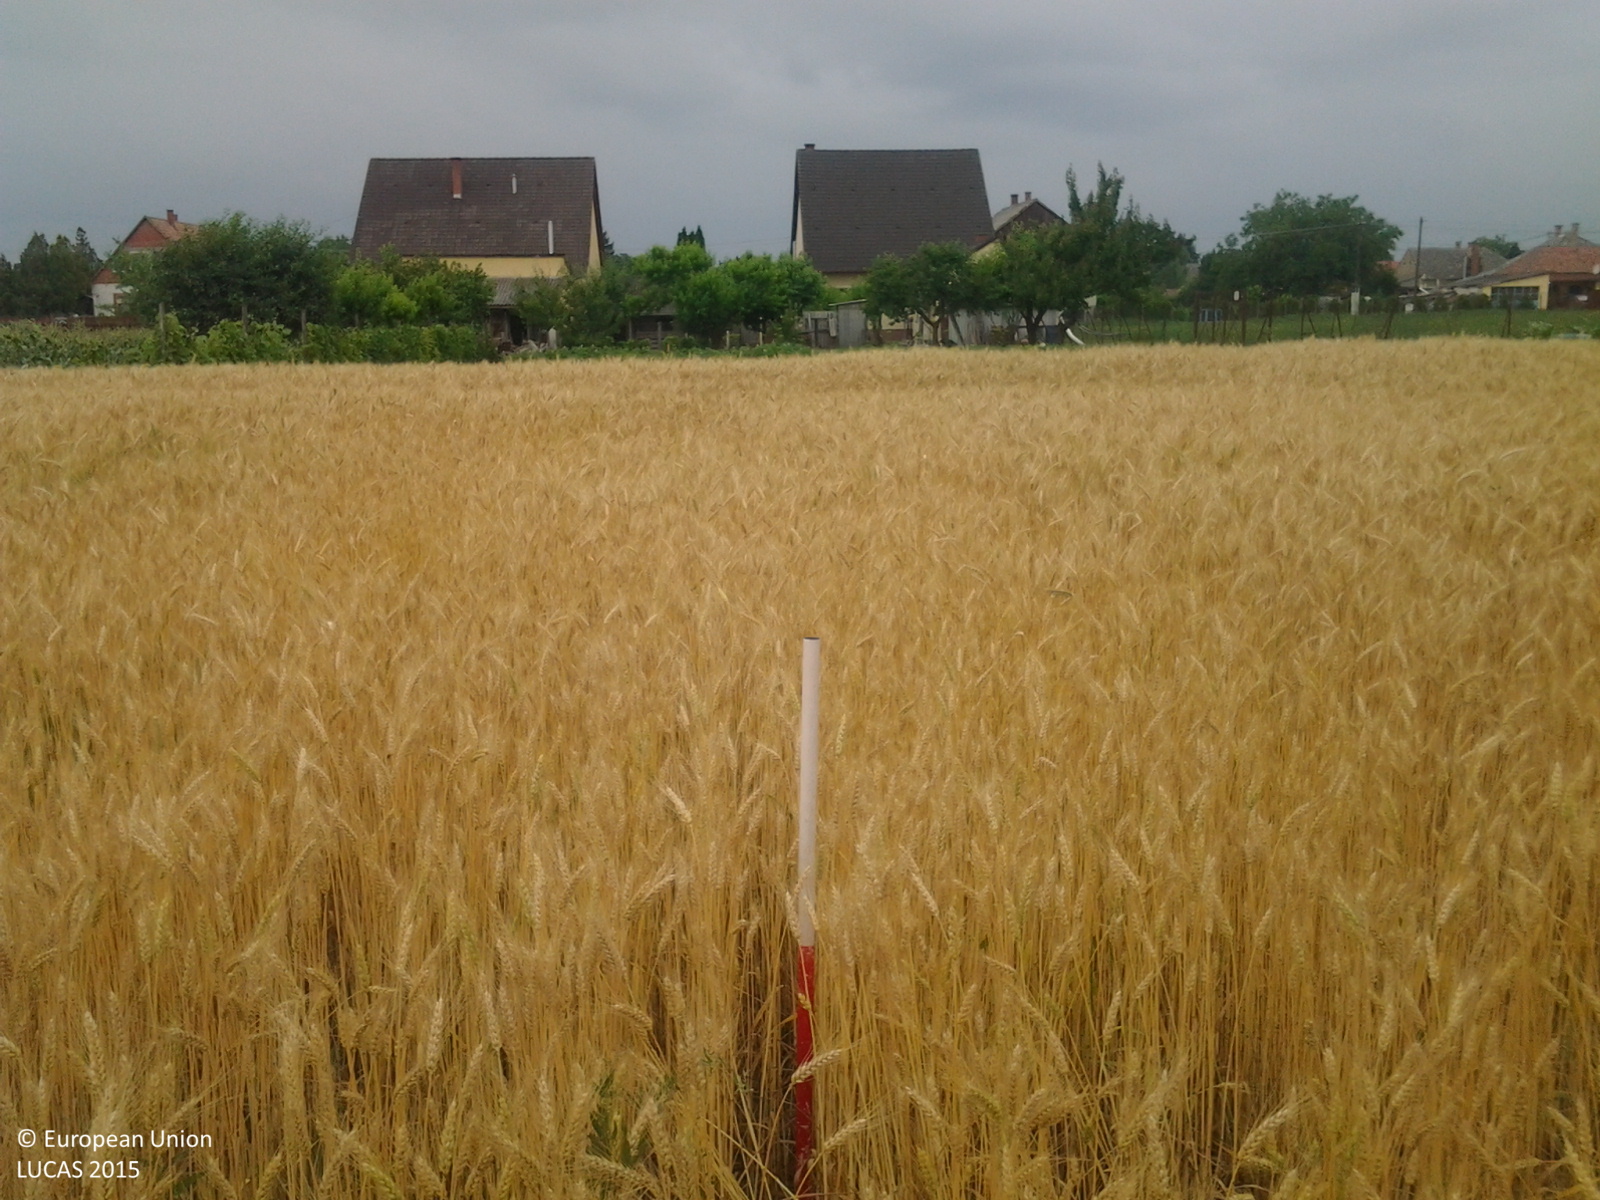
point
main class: Cropland
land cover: Common wheat
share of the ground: > 75 %
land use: Agriculture (excluding fallow land and kitchen gardens)
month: June
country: HU
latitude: 46.4394
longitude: 19.0336
